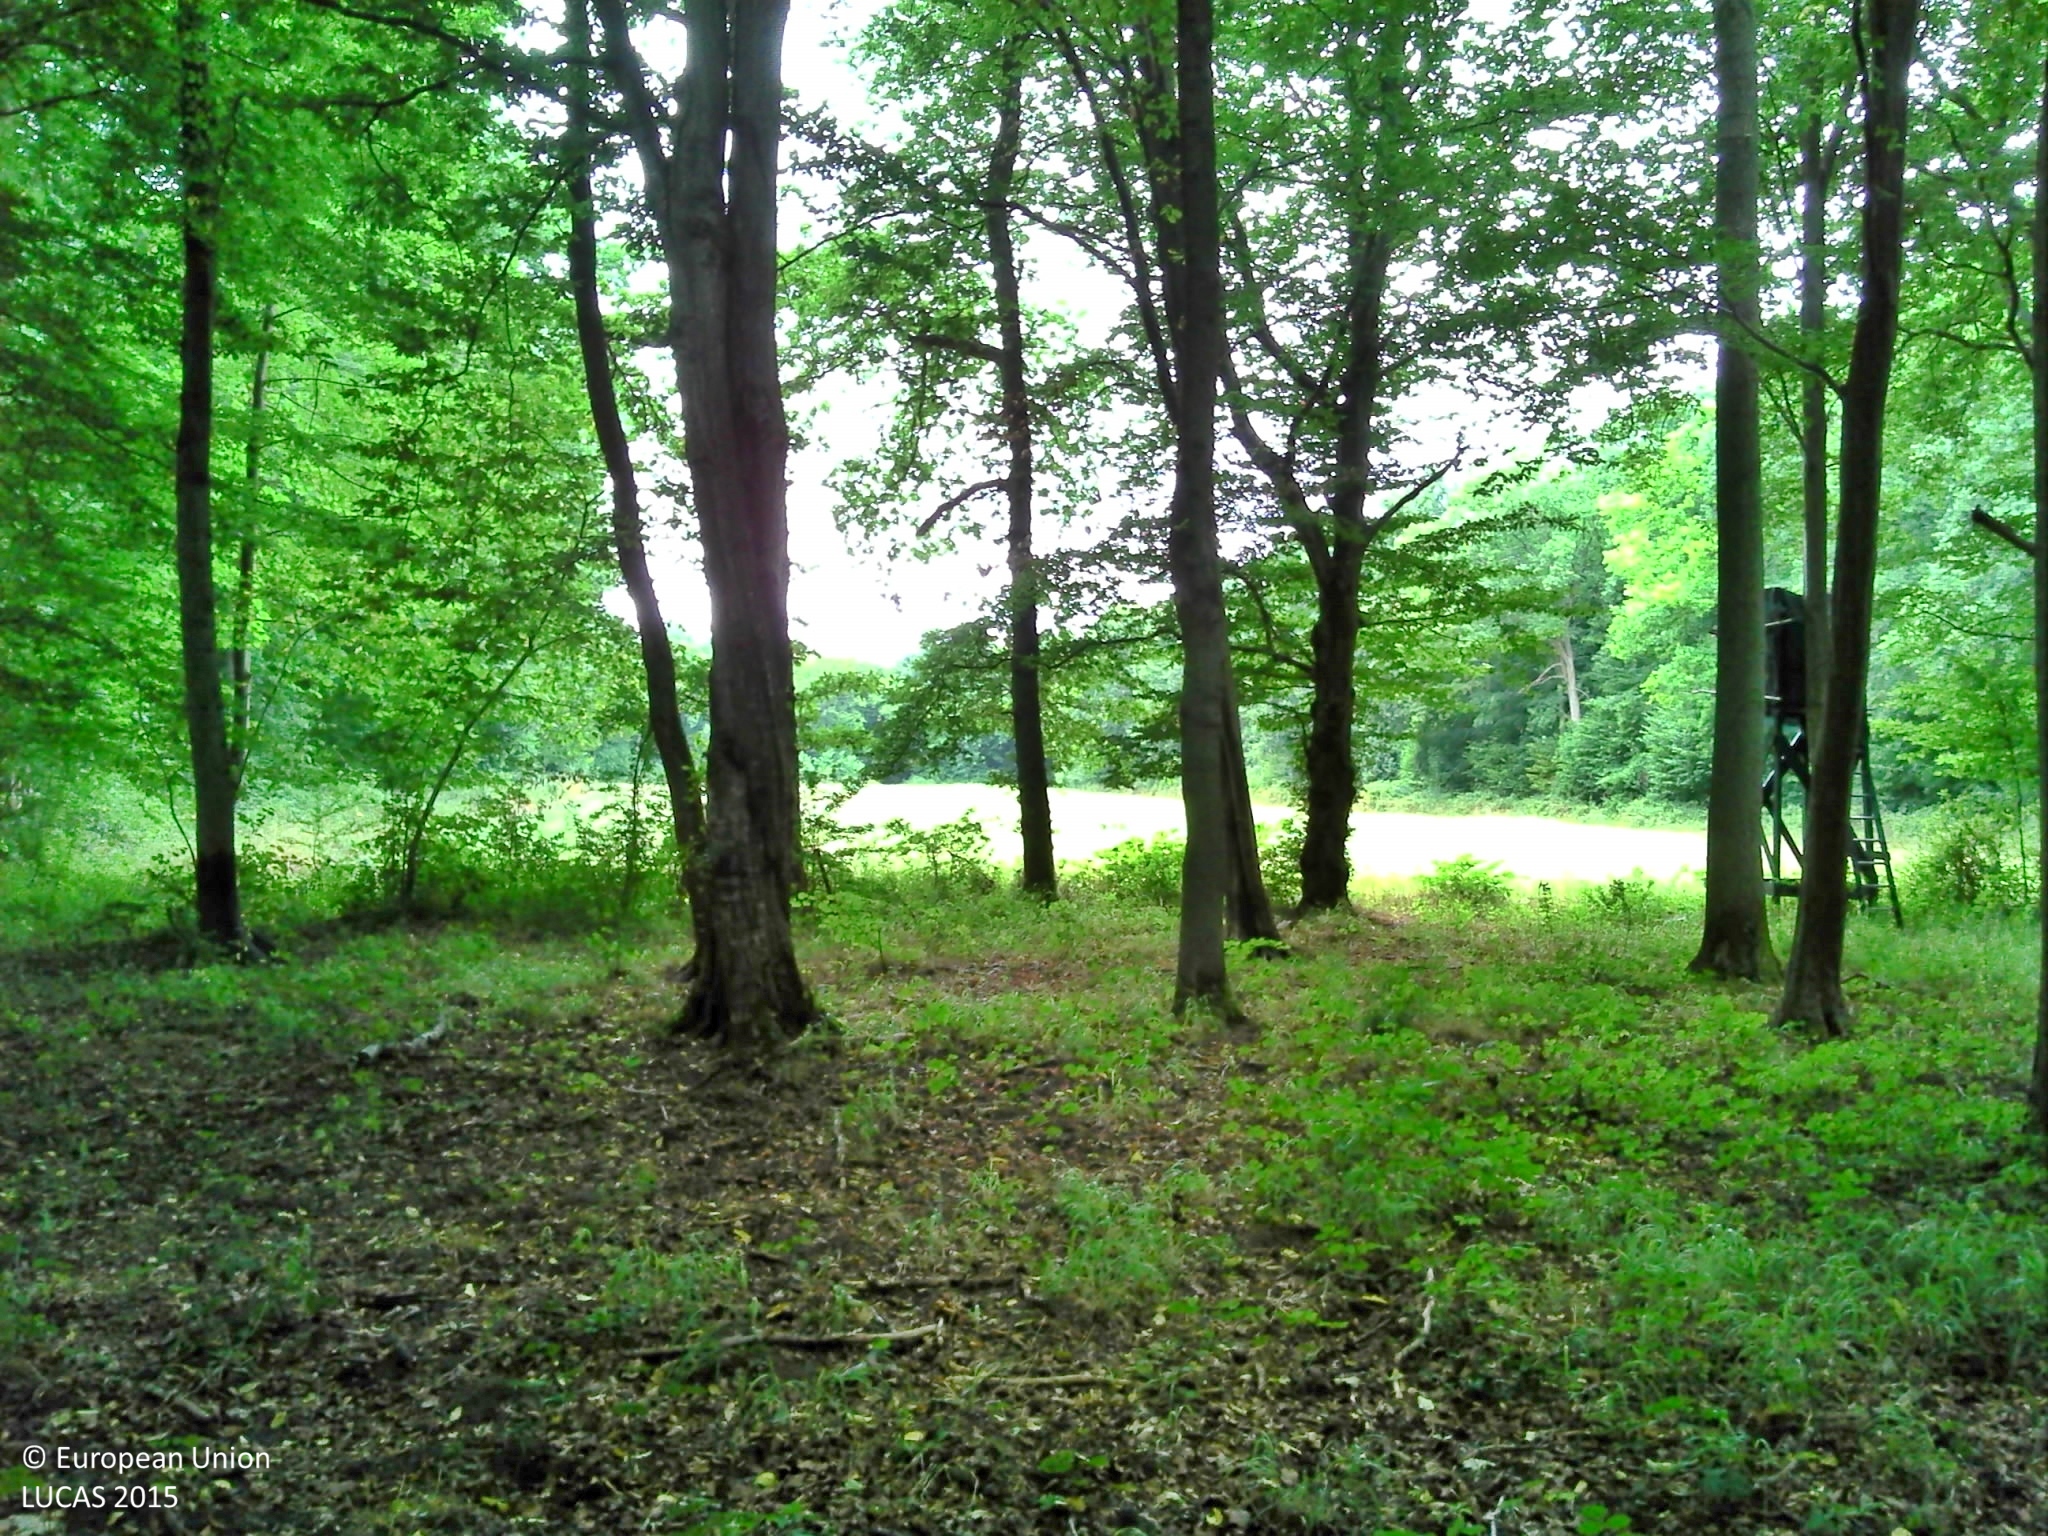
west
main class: Woodland
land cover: Broadleaved woodland
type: acidophilous oak and oak-birch forest
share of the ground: > 75 %
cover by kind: broadleaved forest trees 85 %, herbaceous plants 10 %, unconsolidated bare surface 5 %
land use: Forestry
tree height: > 5 m
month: July
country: FR
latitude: 49.1847
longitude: 2.5939
